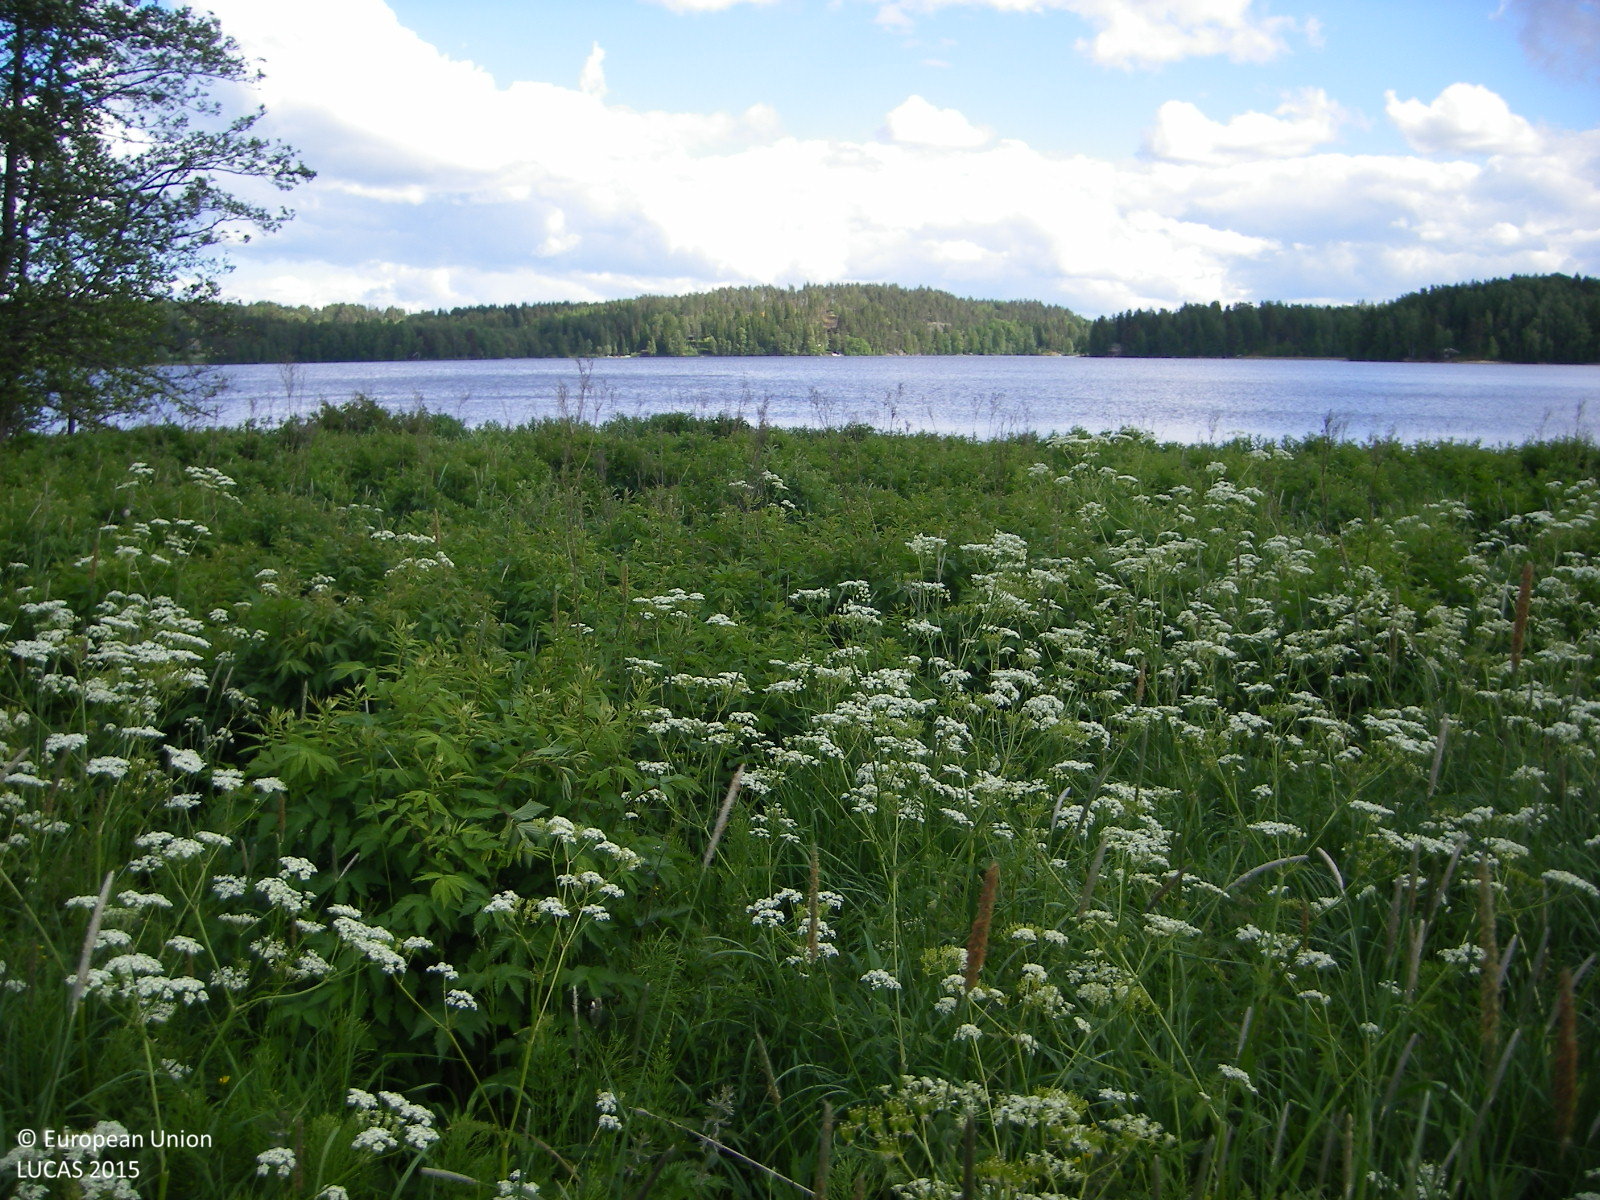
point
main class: Grassland
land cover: Spontaneously vegetated surfaces
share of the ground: > 75 %
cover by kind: herbaceous plants 100 %
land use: Semi-natural and natural areas not in use
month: June
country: FI
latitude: 60.3432
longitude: 24.1416
